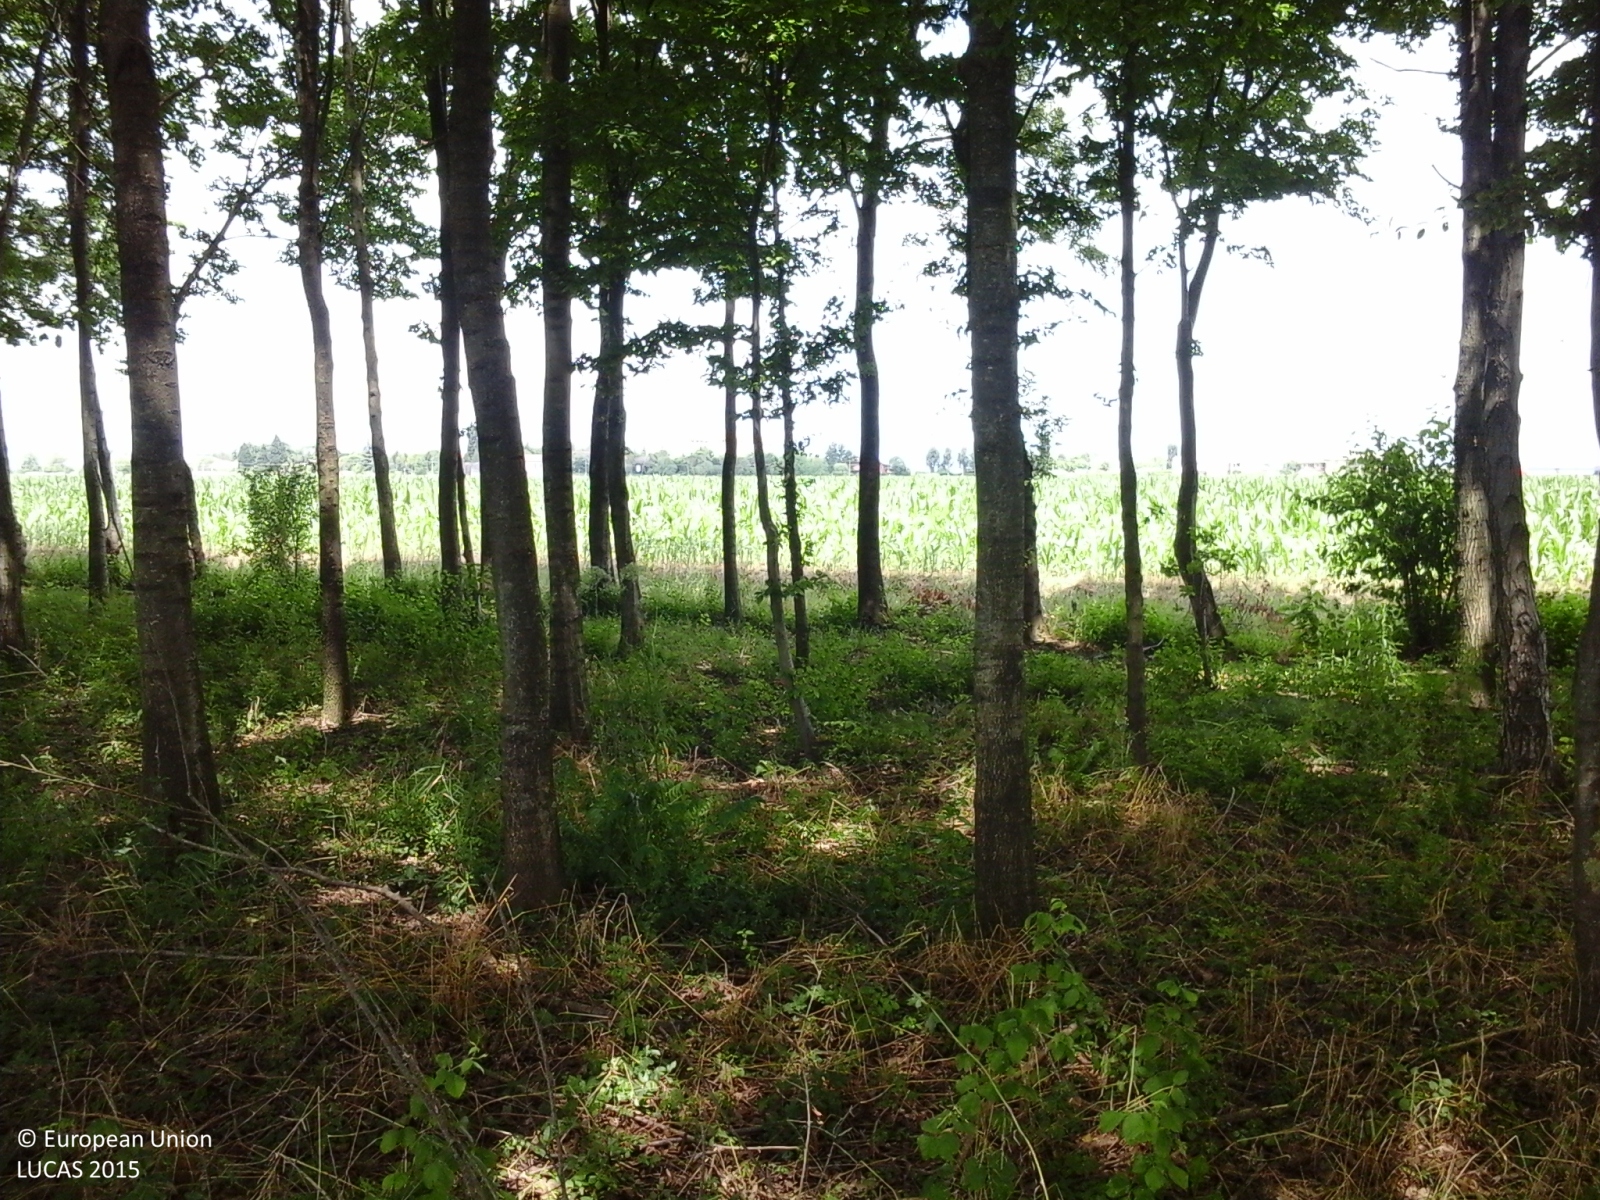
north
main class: Woodland
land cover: Broadleaved woodland
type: thermophilous deciduous forest
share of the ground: > 75 %
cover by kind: broadleaved forest trees 100 %
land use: Forestry
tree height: > 5 m
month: June
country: IT
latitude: 45.6340
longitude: 12.6260
